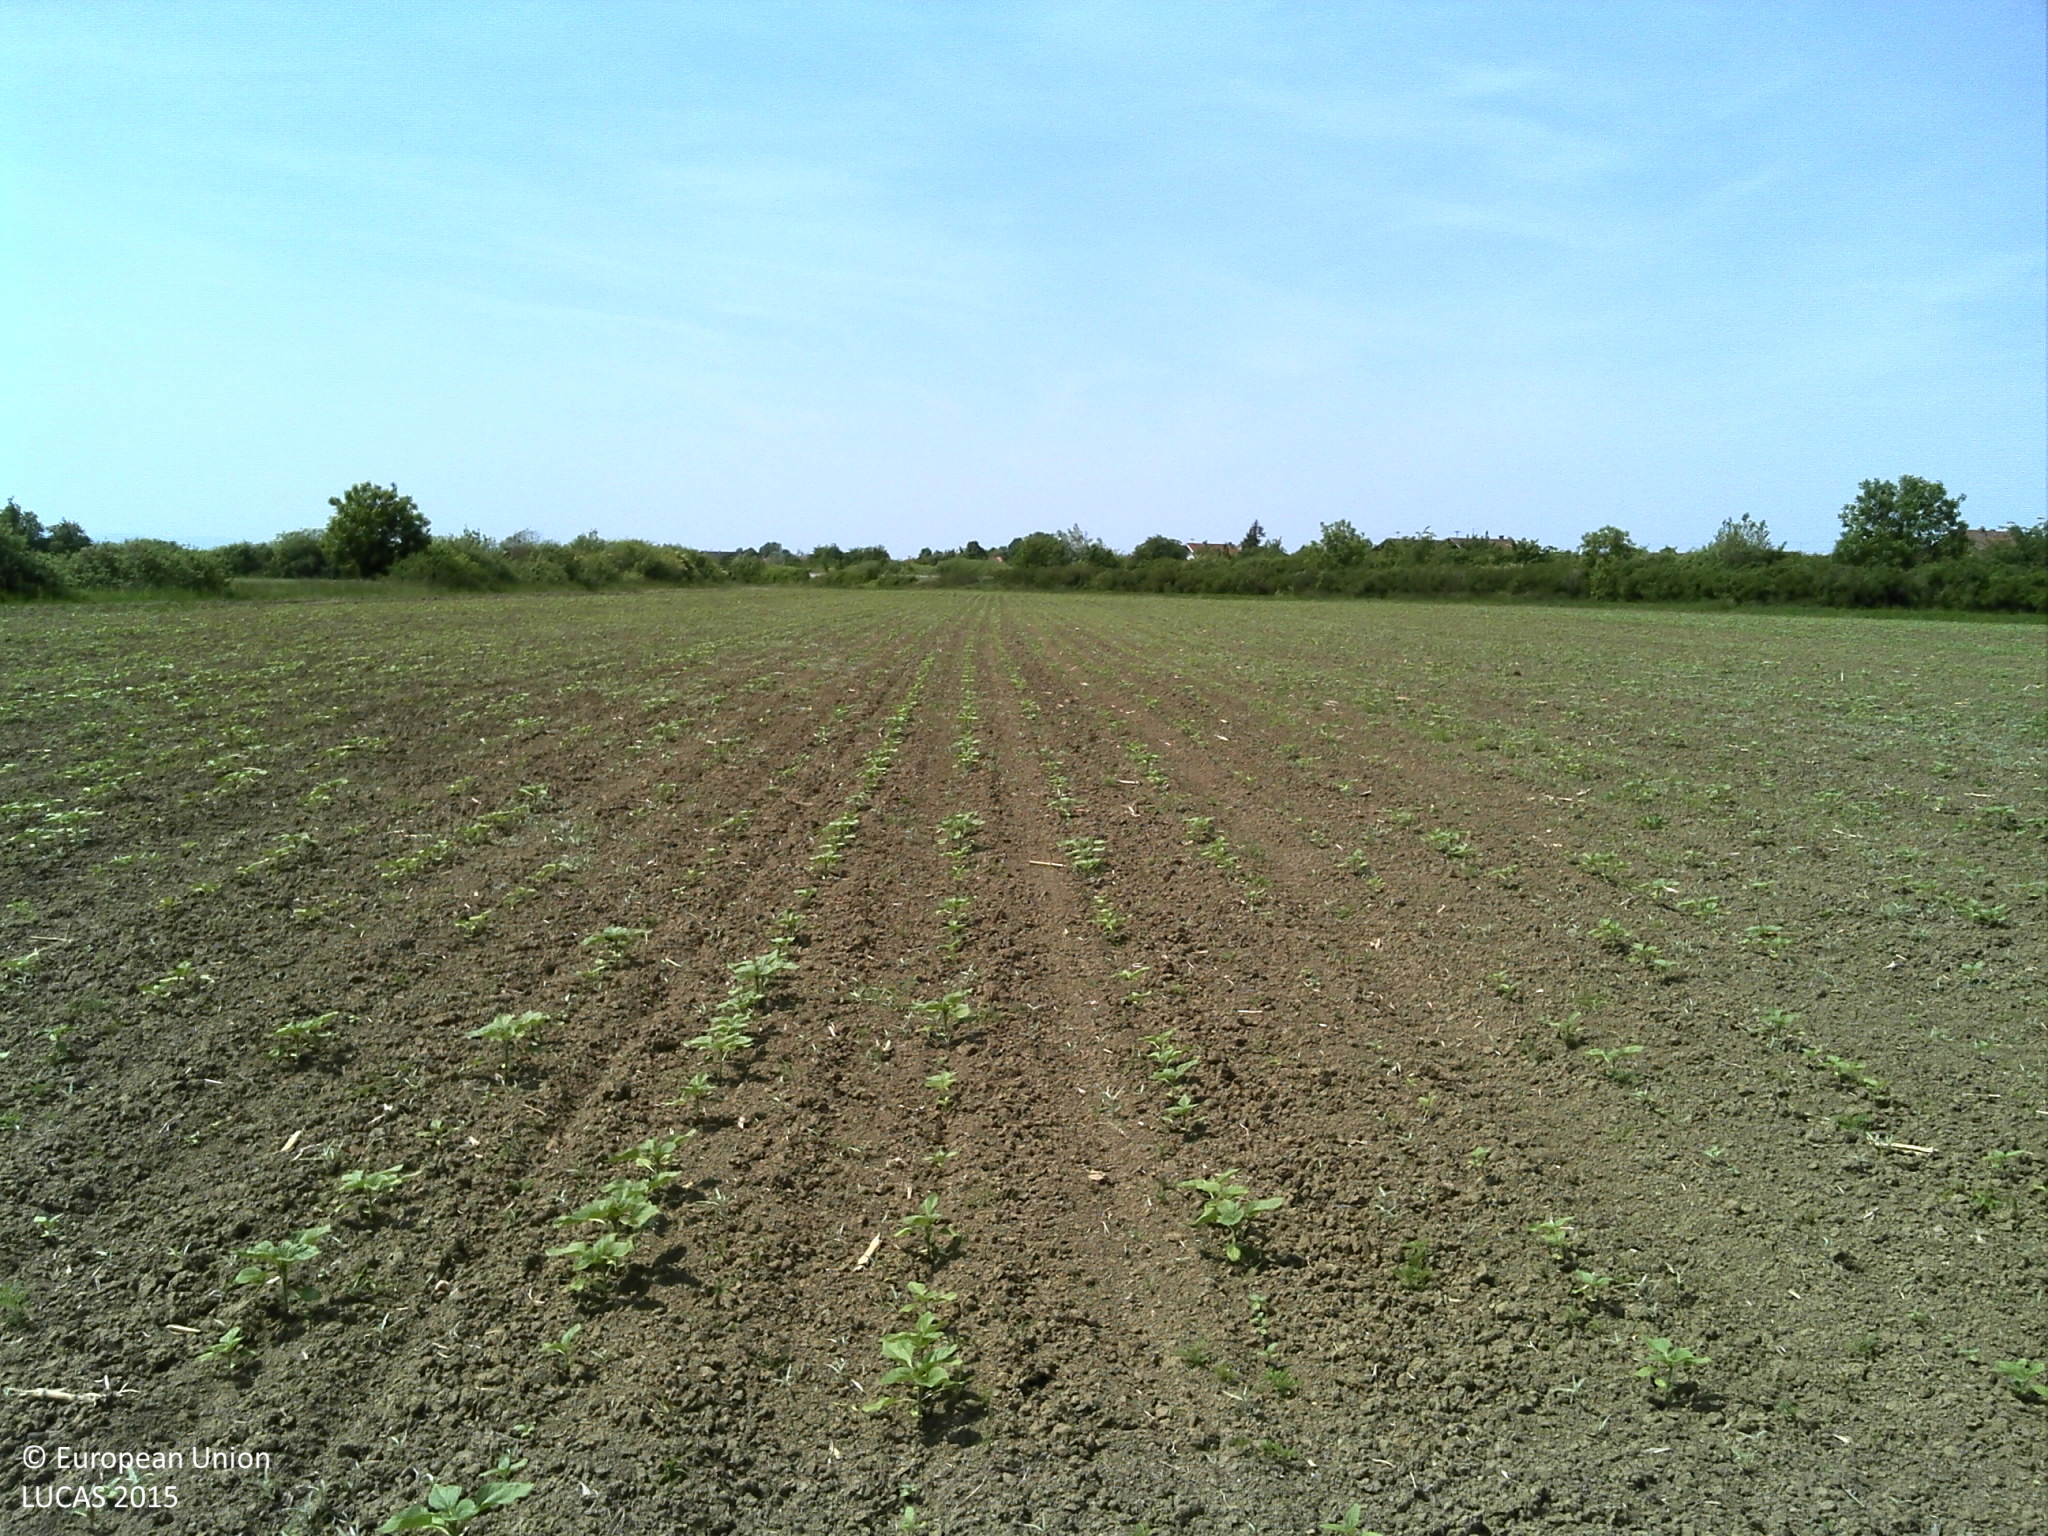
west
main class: Cropland
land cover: Soya
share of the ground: < 10 %
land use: Agriculture (excluding fallow land and kitchen gardens)
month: May
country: HR
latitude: 45.5301
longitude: 18.1868
